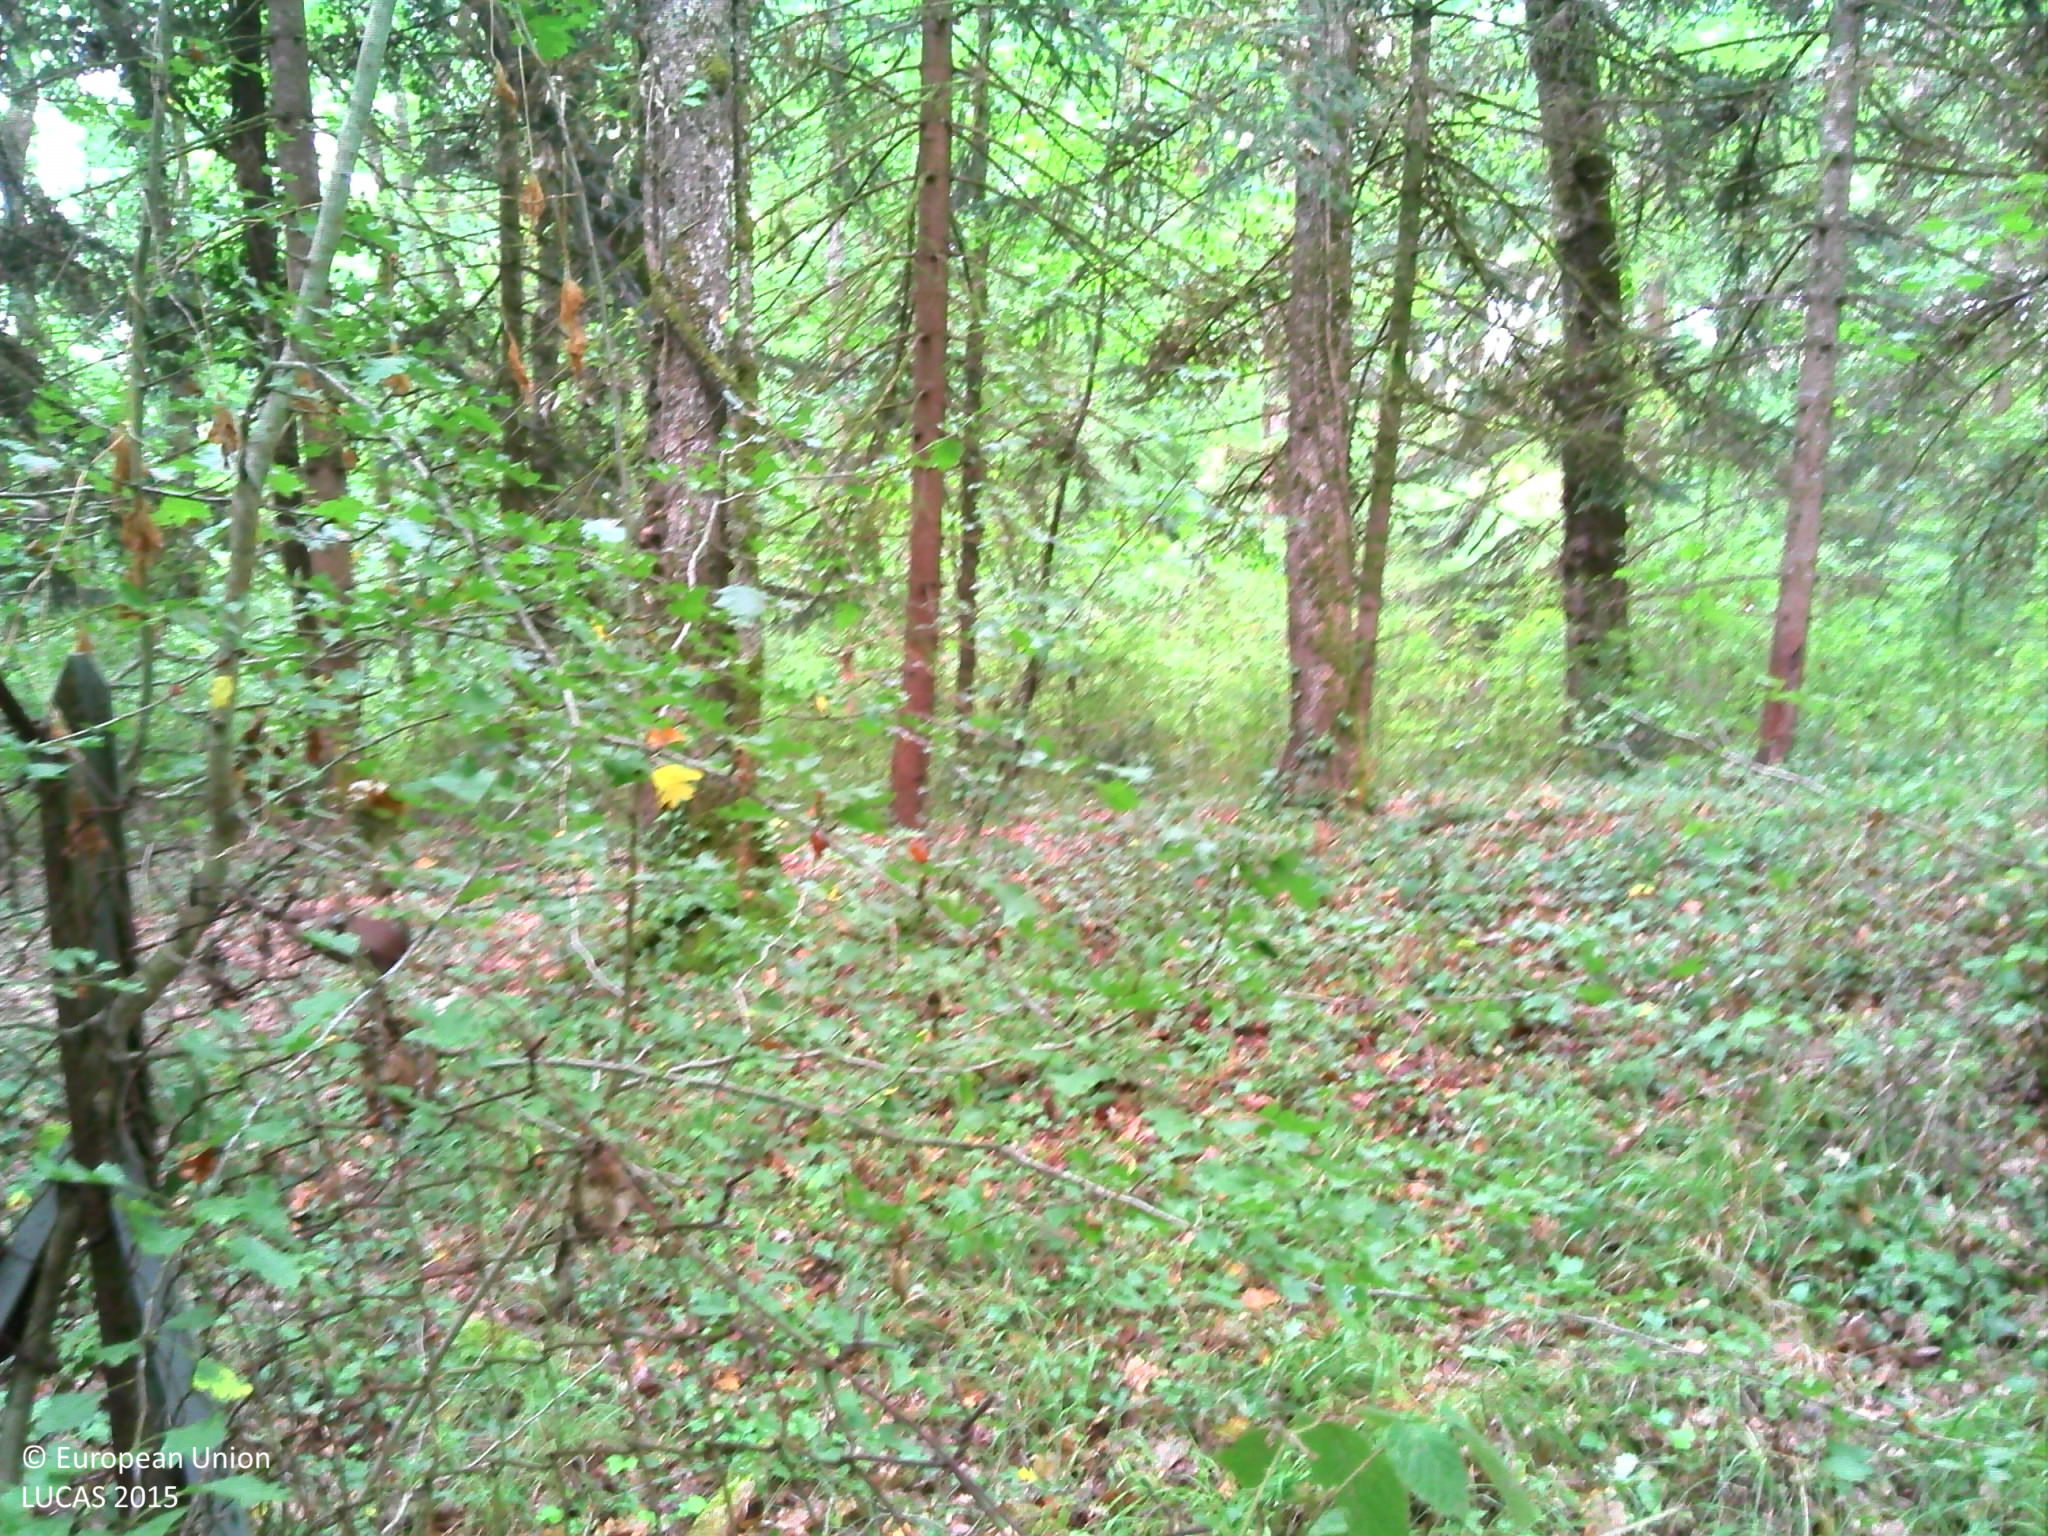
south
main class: Woodland
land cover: Broadleaved woodland
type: thermophilous deciduous forest
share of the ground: > 75 %
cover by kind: broadleaved forest trees 85 %, herbaceous plants 15 %
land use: Forestry
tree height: > 5 m
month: August
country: FR
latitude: 44.2376
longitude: 0.6667
